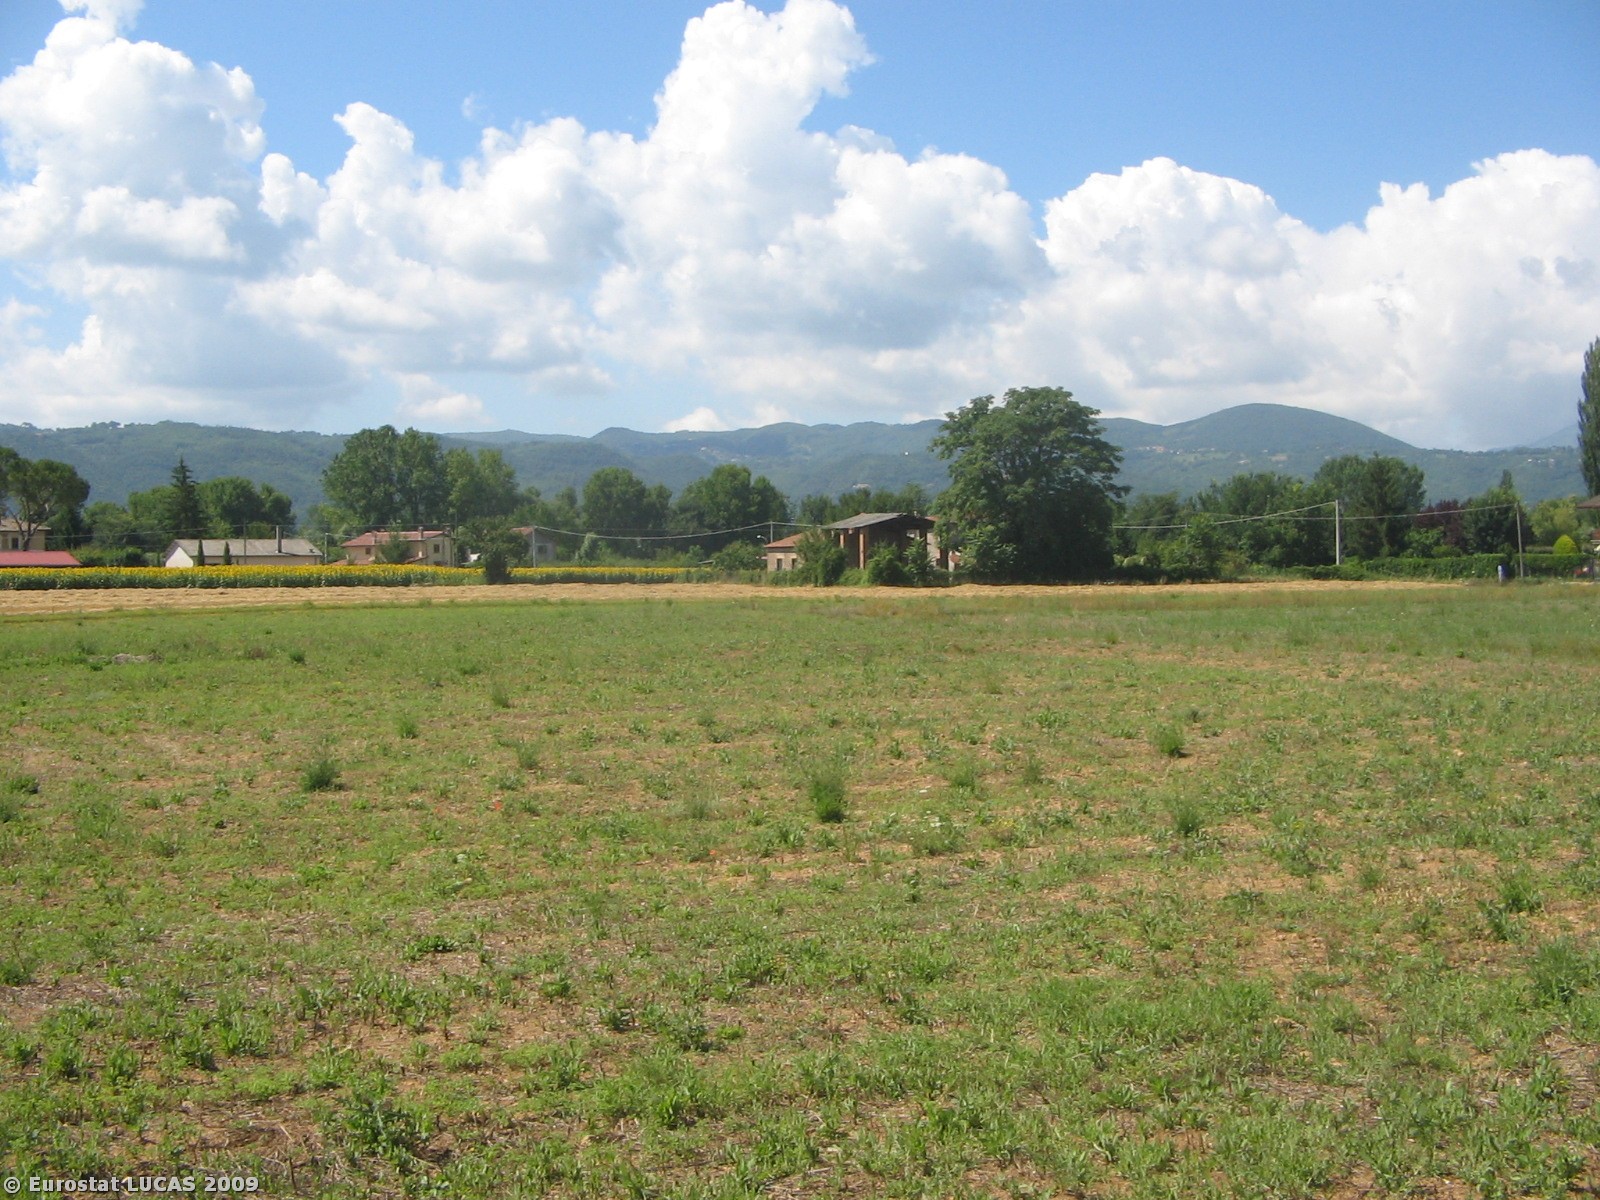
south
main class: Grassland
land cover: Spontaneously vegetated surfaces
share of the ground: > 75 %
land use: Fallow land
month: July
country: IT
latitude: 42.4152
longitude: 12.8464
